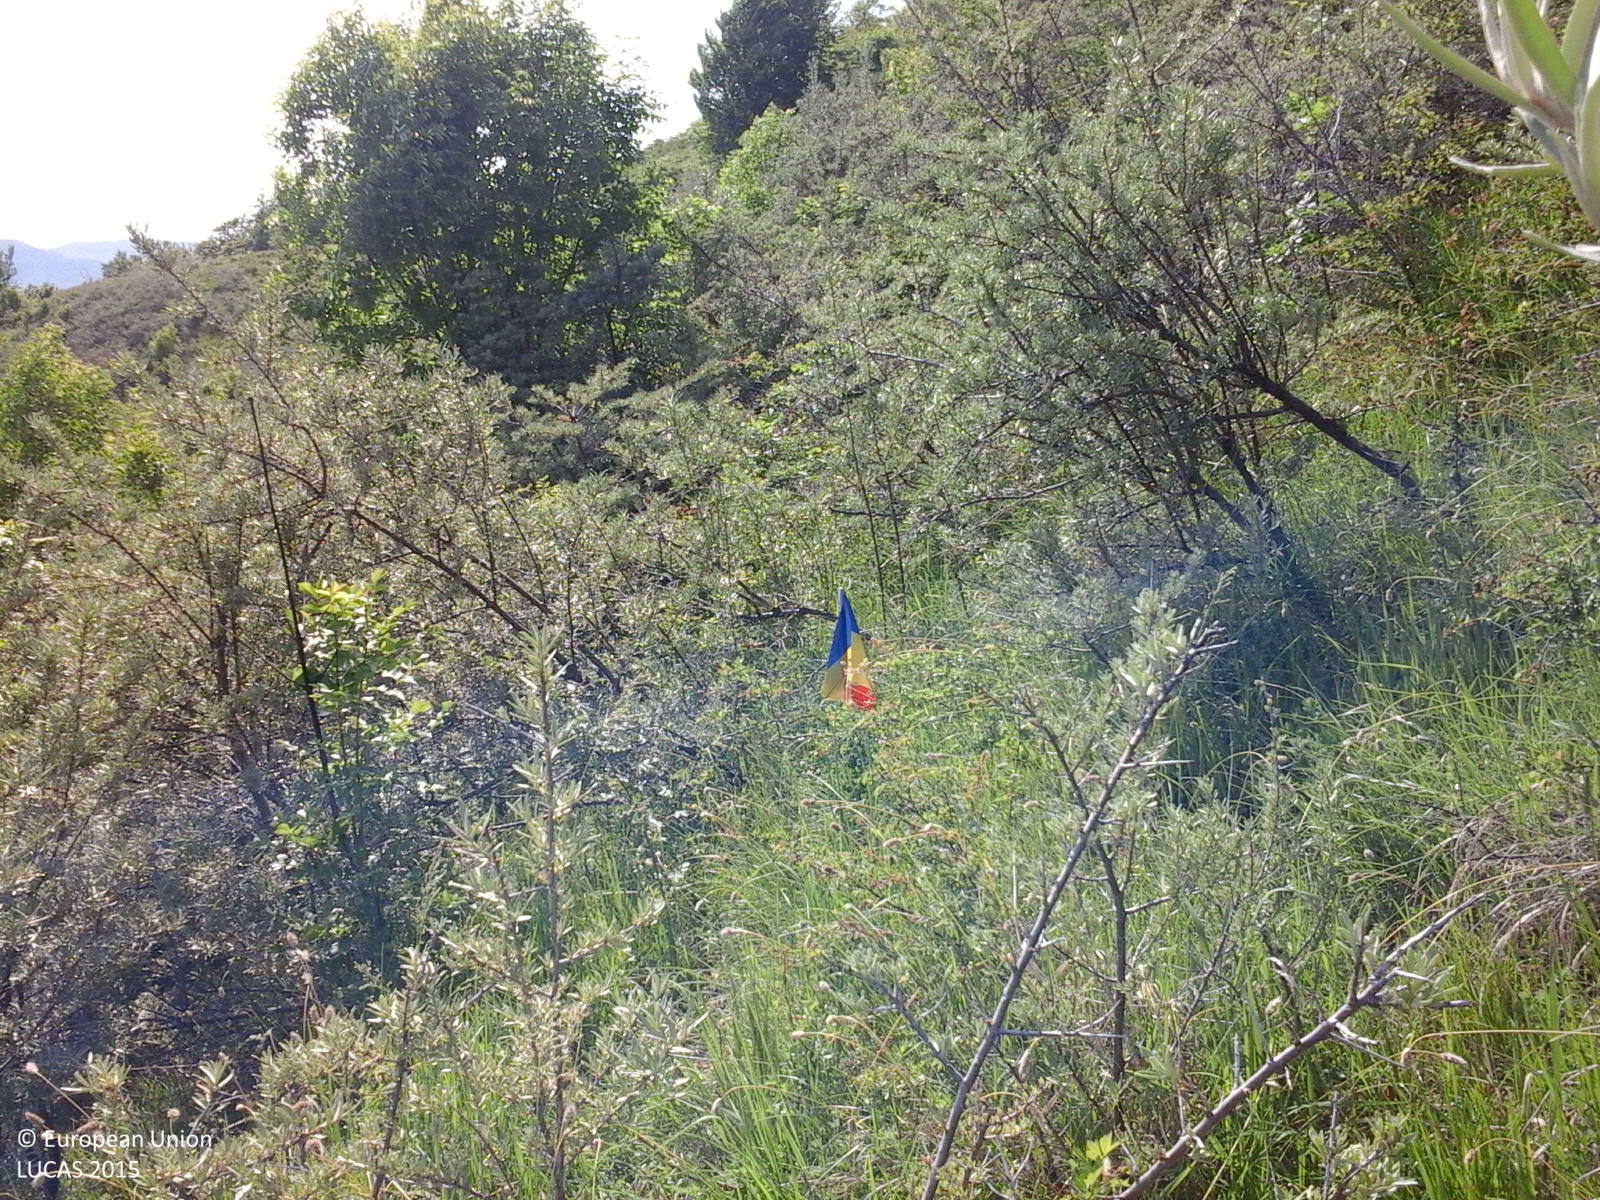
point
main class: Shrubland
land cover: Shrubland with sparse tree cover
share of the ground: > 75 %
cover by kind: shrubs 95 %, broadleaved forest trees 5 %
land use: Forestry
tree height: < 5 m
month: May
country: RO
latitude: 45.4228
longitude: 26.2862
